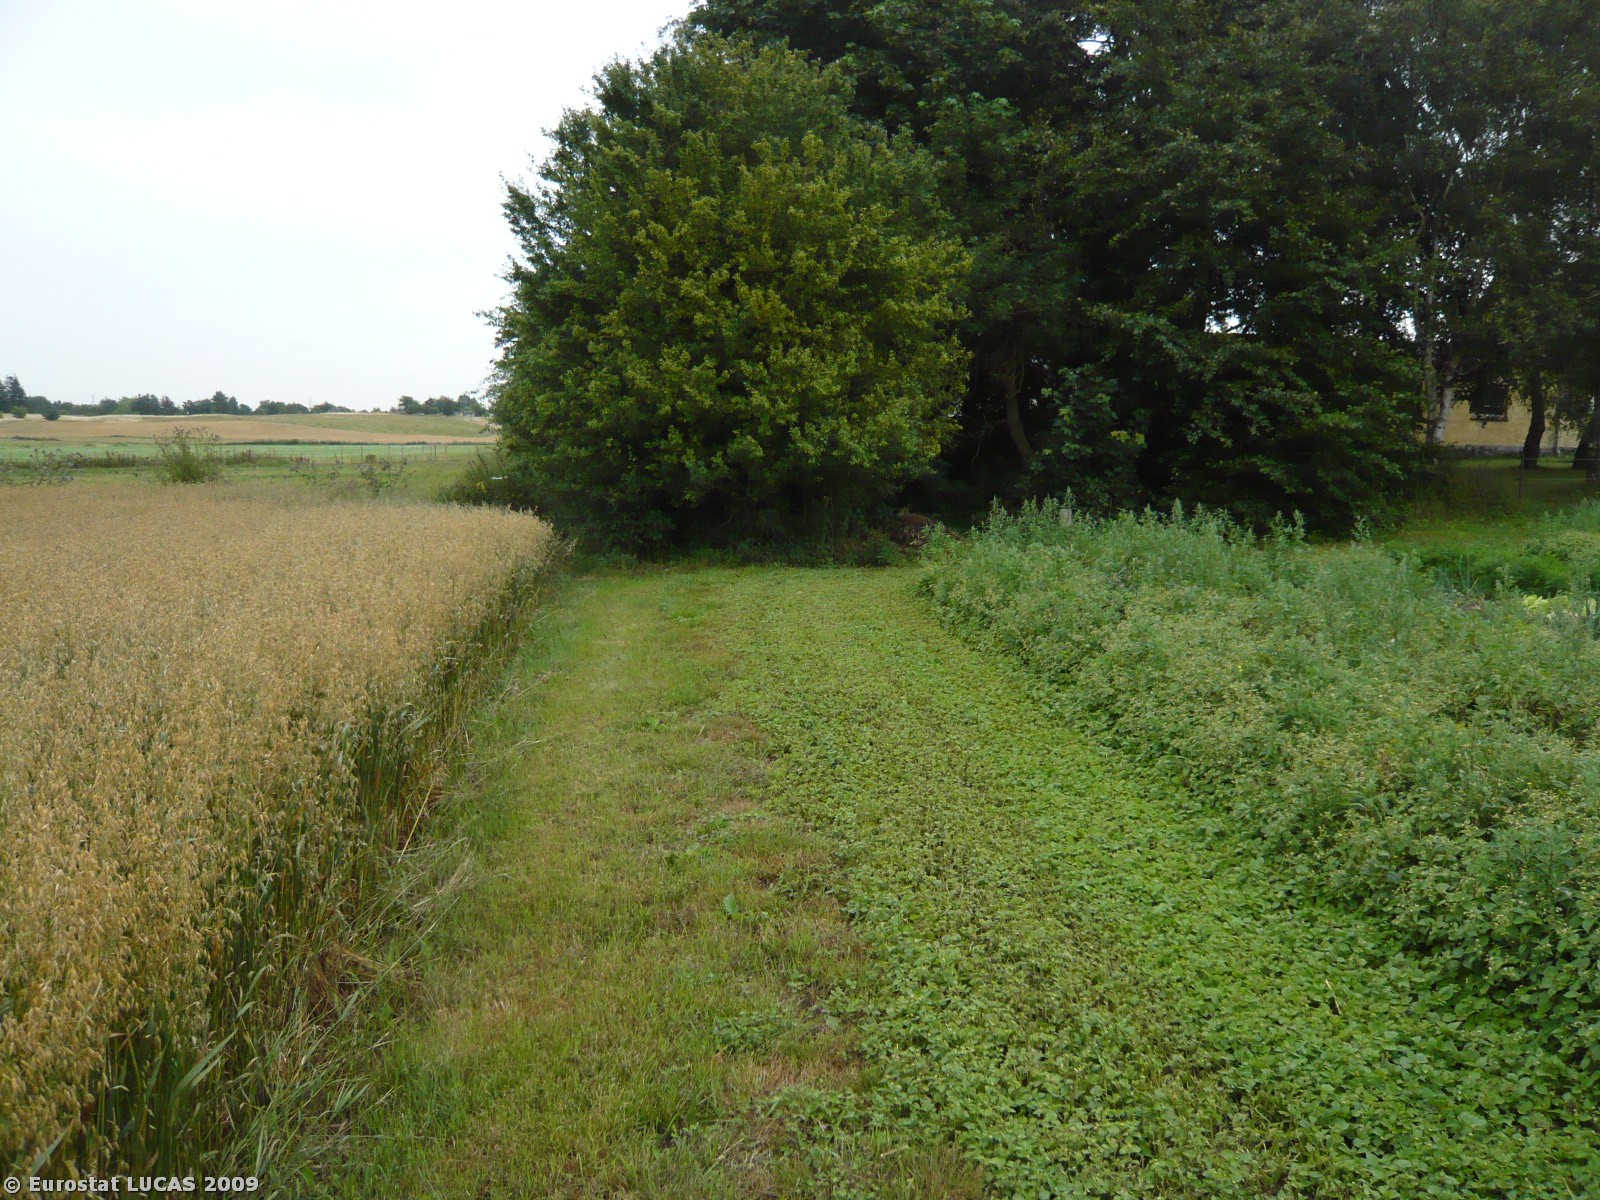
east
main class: Cropland
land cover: Oats
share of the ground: > 75 %
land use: Agriculture (excluding fallow land and kitchen gardens)
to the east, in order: Oats; Fences; Grassland without tree/shrub cover; Fences; Tracks; Fences; Grassland without tree/shrub cover
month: July
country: DK
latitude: 55.7377
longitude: 12.1801
